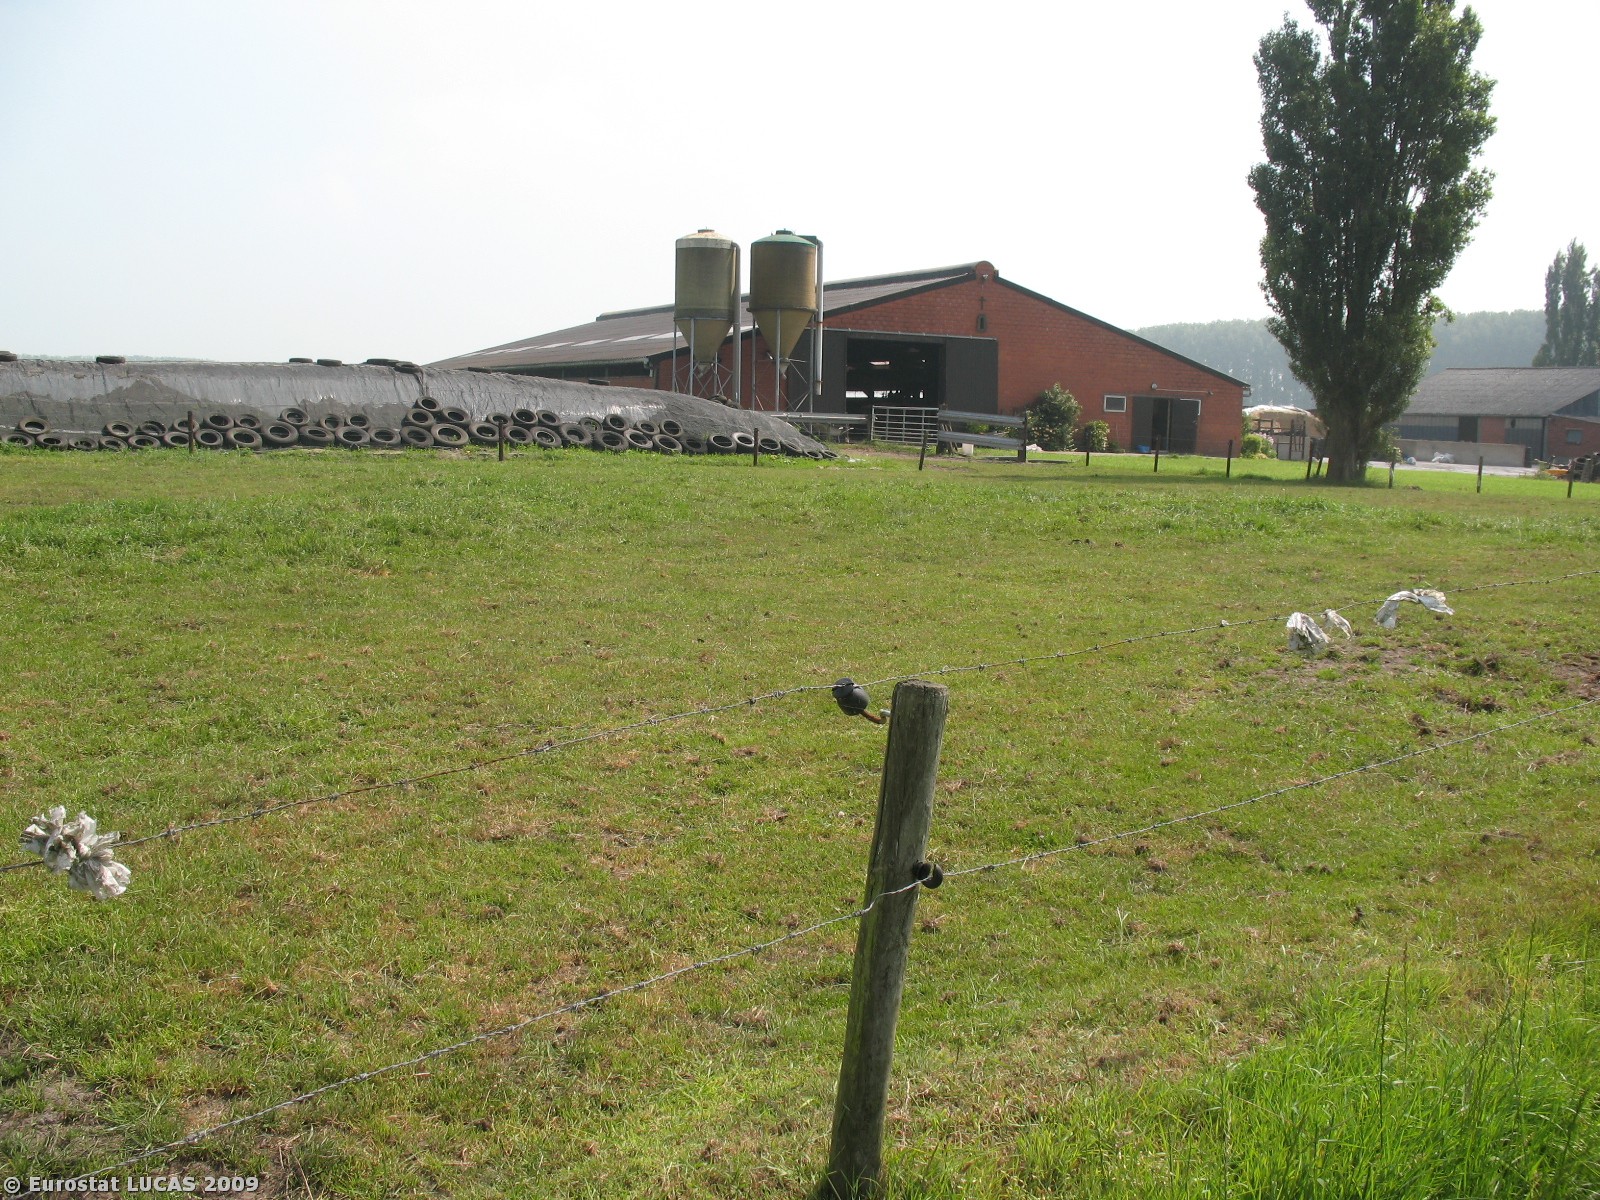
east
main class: Grassland
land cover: Grassland without tree/shrub cover
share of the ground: > 75 %
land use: Agriculture (excluding fallow land and kitchen gardens)
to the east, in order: Grassland without tree/shrub cover; Fences; Grassland without tree/shrub cover; Fences; Grassland without tree/shrub cover; Fences; Grassland without tree/shrub cover; Fences; Ditches and canals; Grass margins; Fences; Grassland without tree/shrub cover
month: June
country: BE
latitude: 51.2188
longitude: 3.7077
